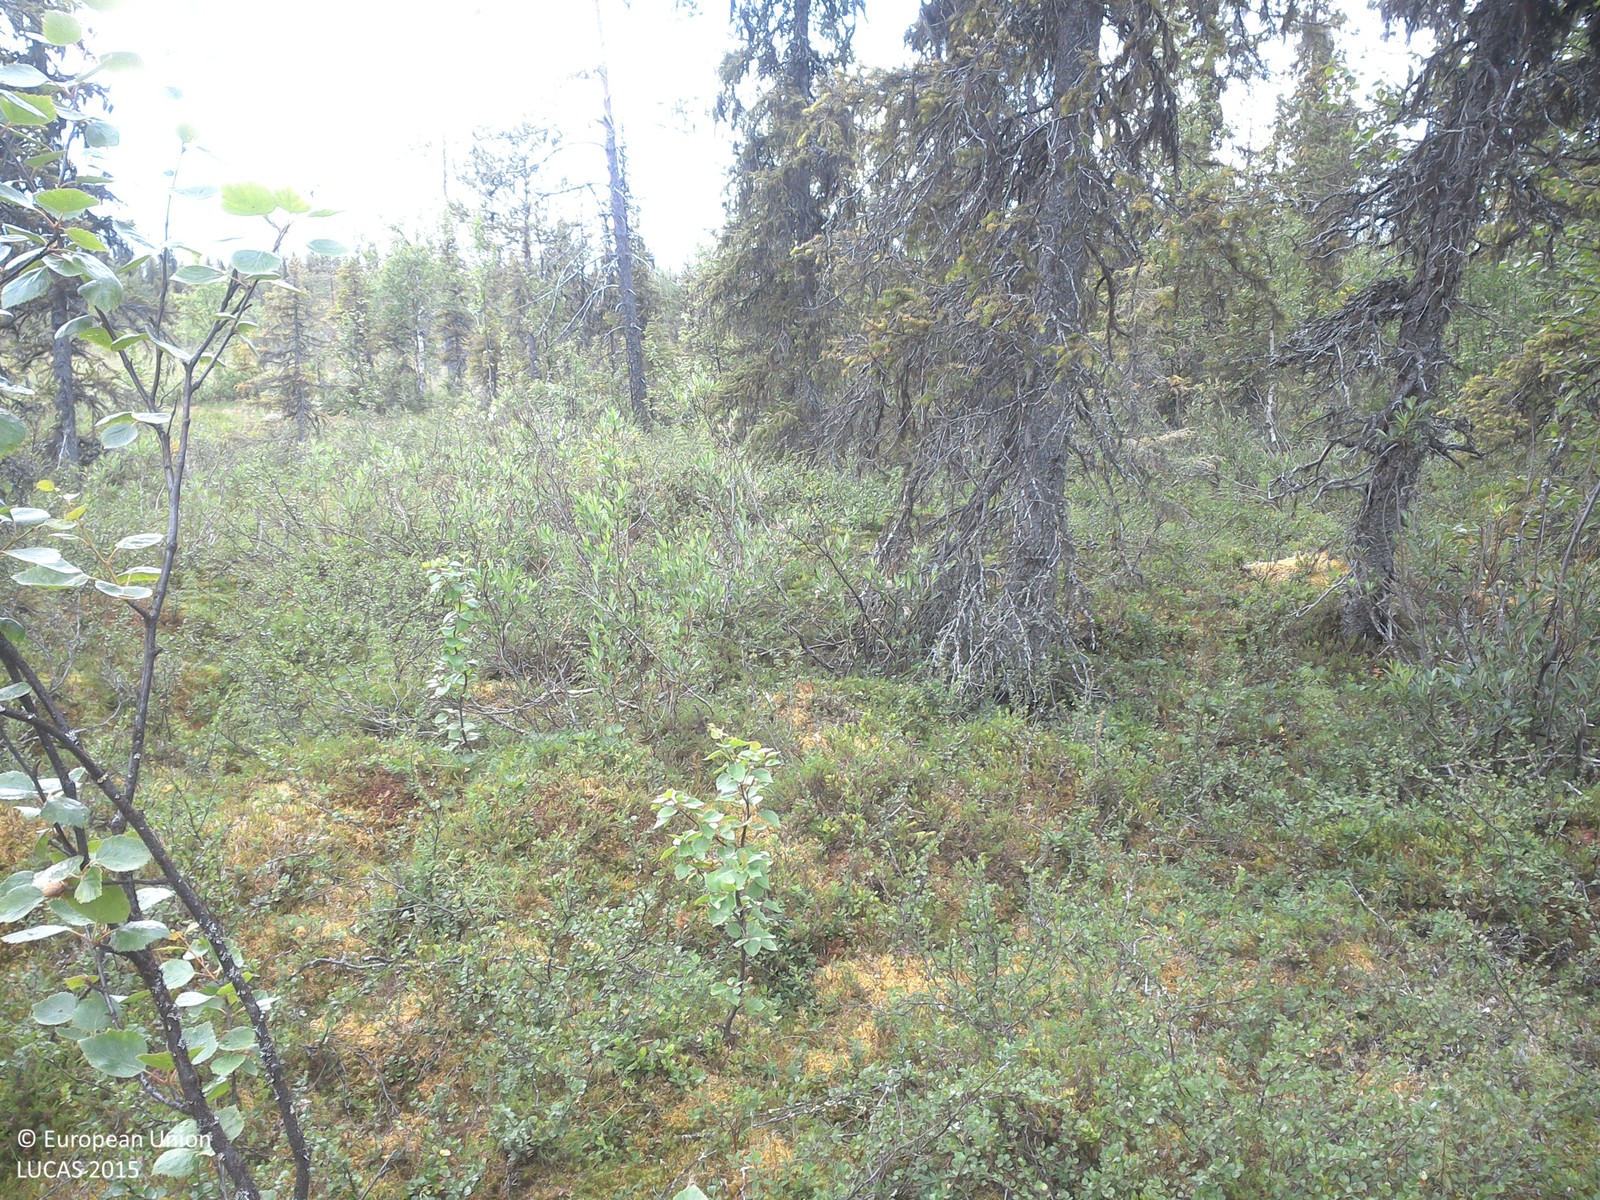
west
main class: Woodland
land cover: Spruce dominated mixed woodland
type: boreal forest
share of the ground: 10 - 25 %
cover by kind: shrubs 70 %, coniferous forest trees 15 %, lichens and mosses 10 %, broadleaved forest trees 5 %
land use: Forestry
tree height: > 5 m
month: July
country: SE
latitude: 67.4780
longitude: 22.0491
